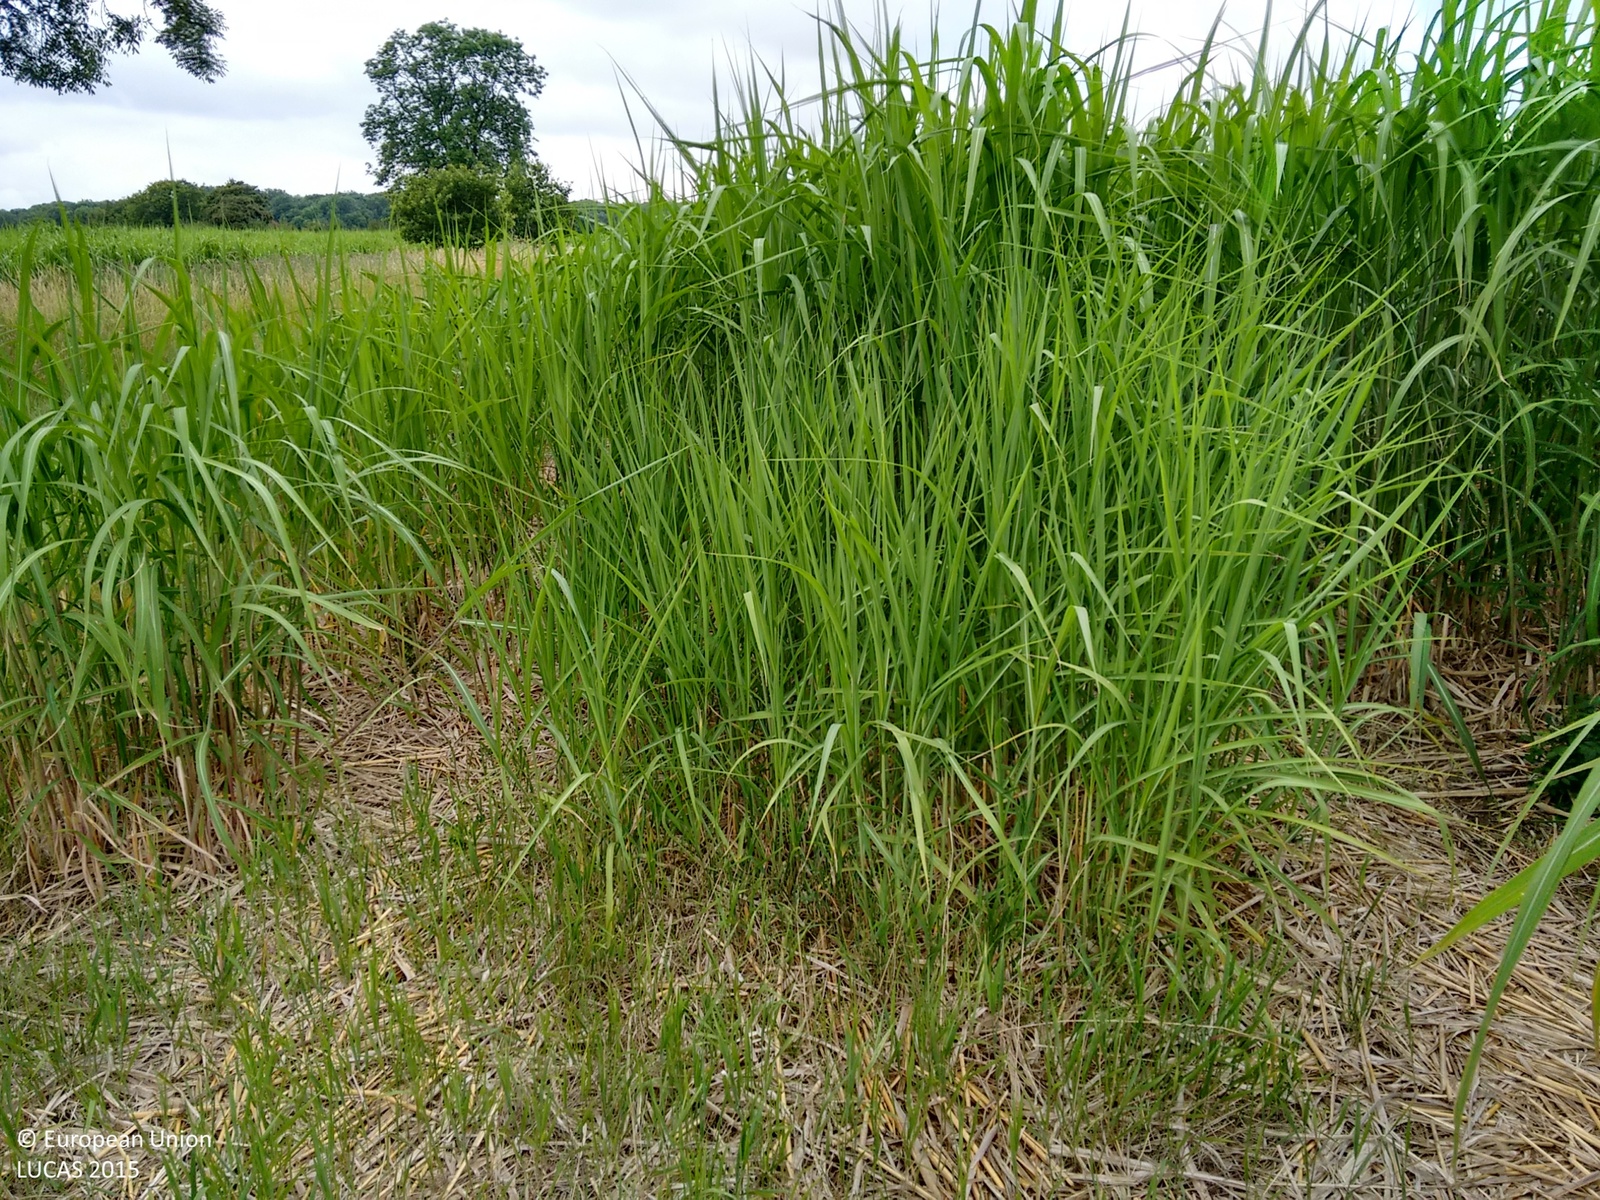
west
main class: Cropland
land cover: Permanent industrial crops
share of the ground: > 75 %
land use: Agriculture (excluding fallow land and kitchen gardens)
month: July
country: GB
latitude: 52.5077
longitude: -0.5137
